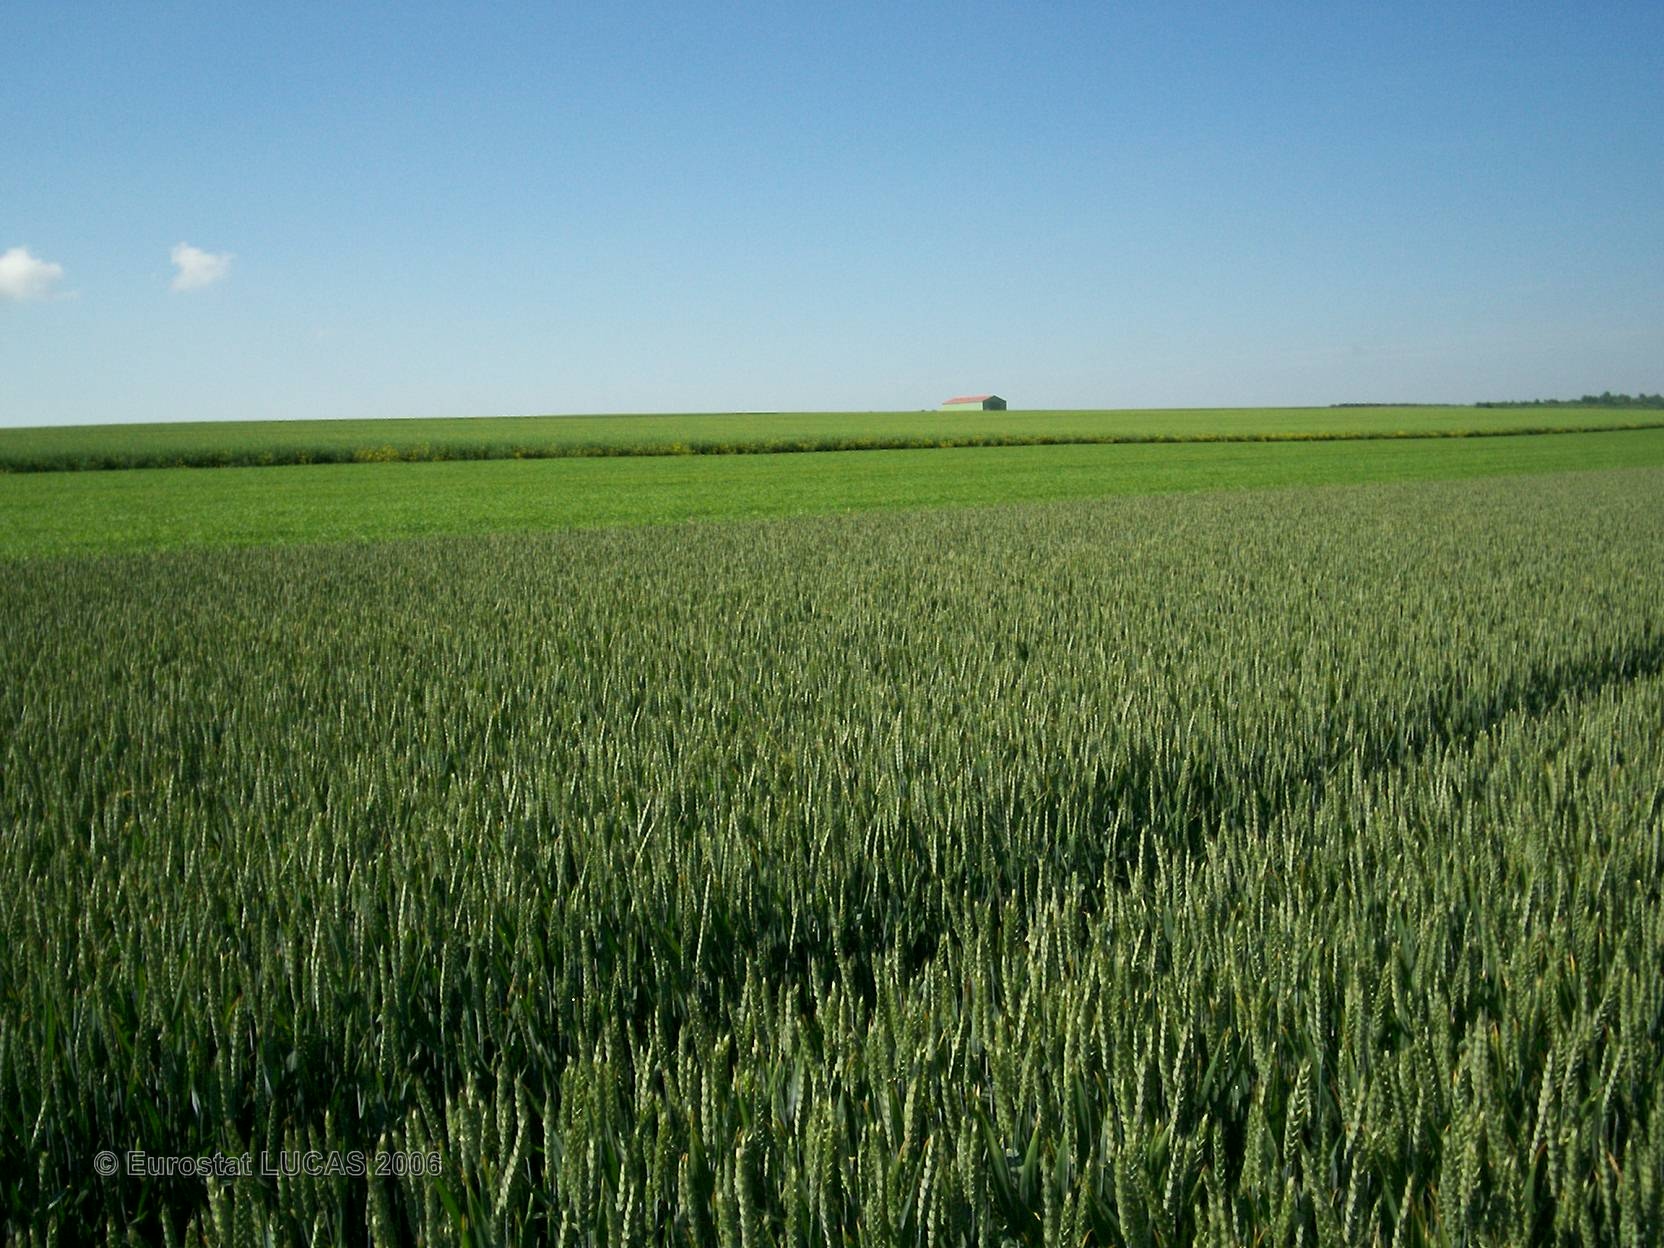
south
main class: Cropland
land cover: Common wheat
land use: Agriculture (excluding fallow land and kitchen gardens)
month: June
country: FR
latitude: 48.8233
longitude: 4.4531
